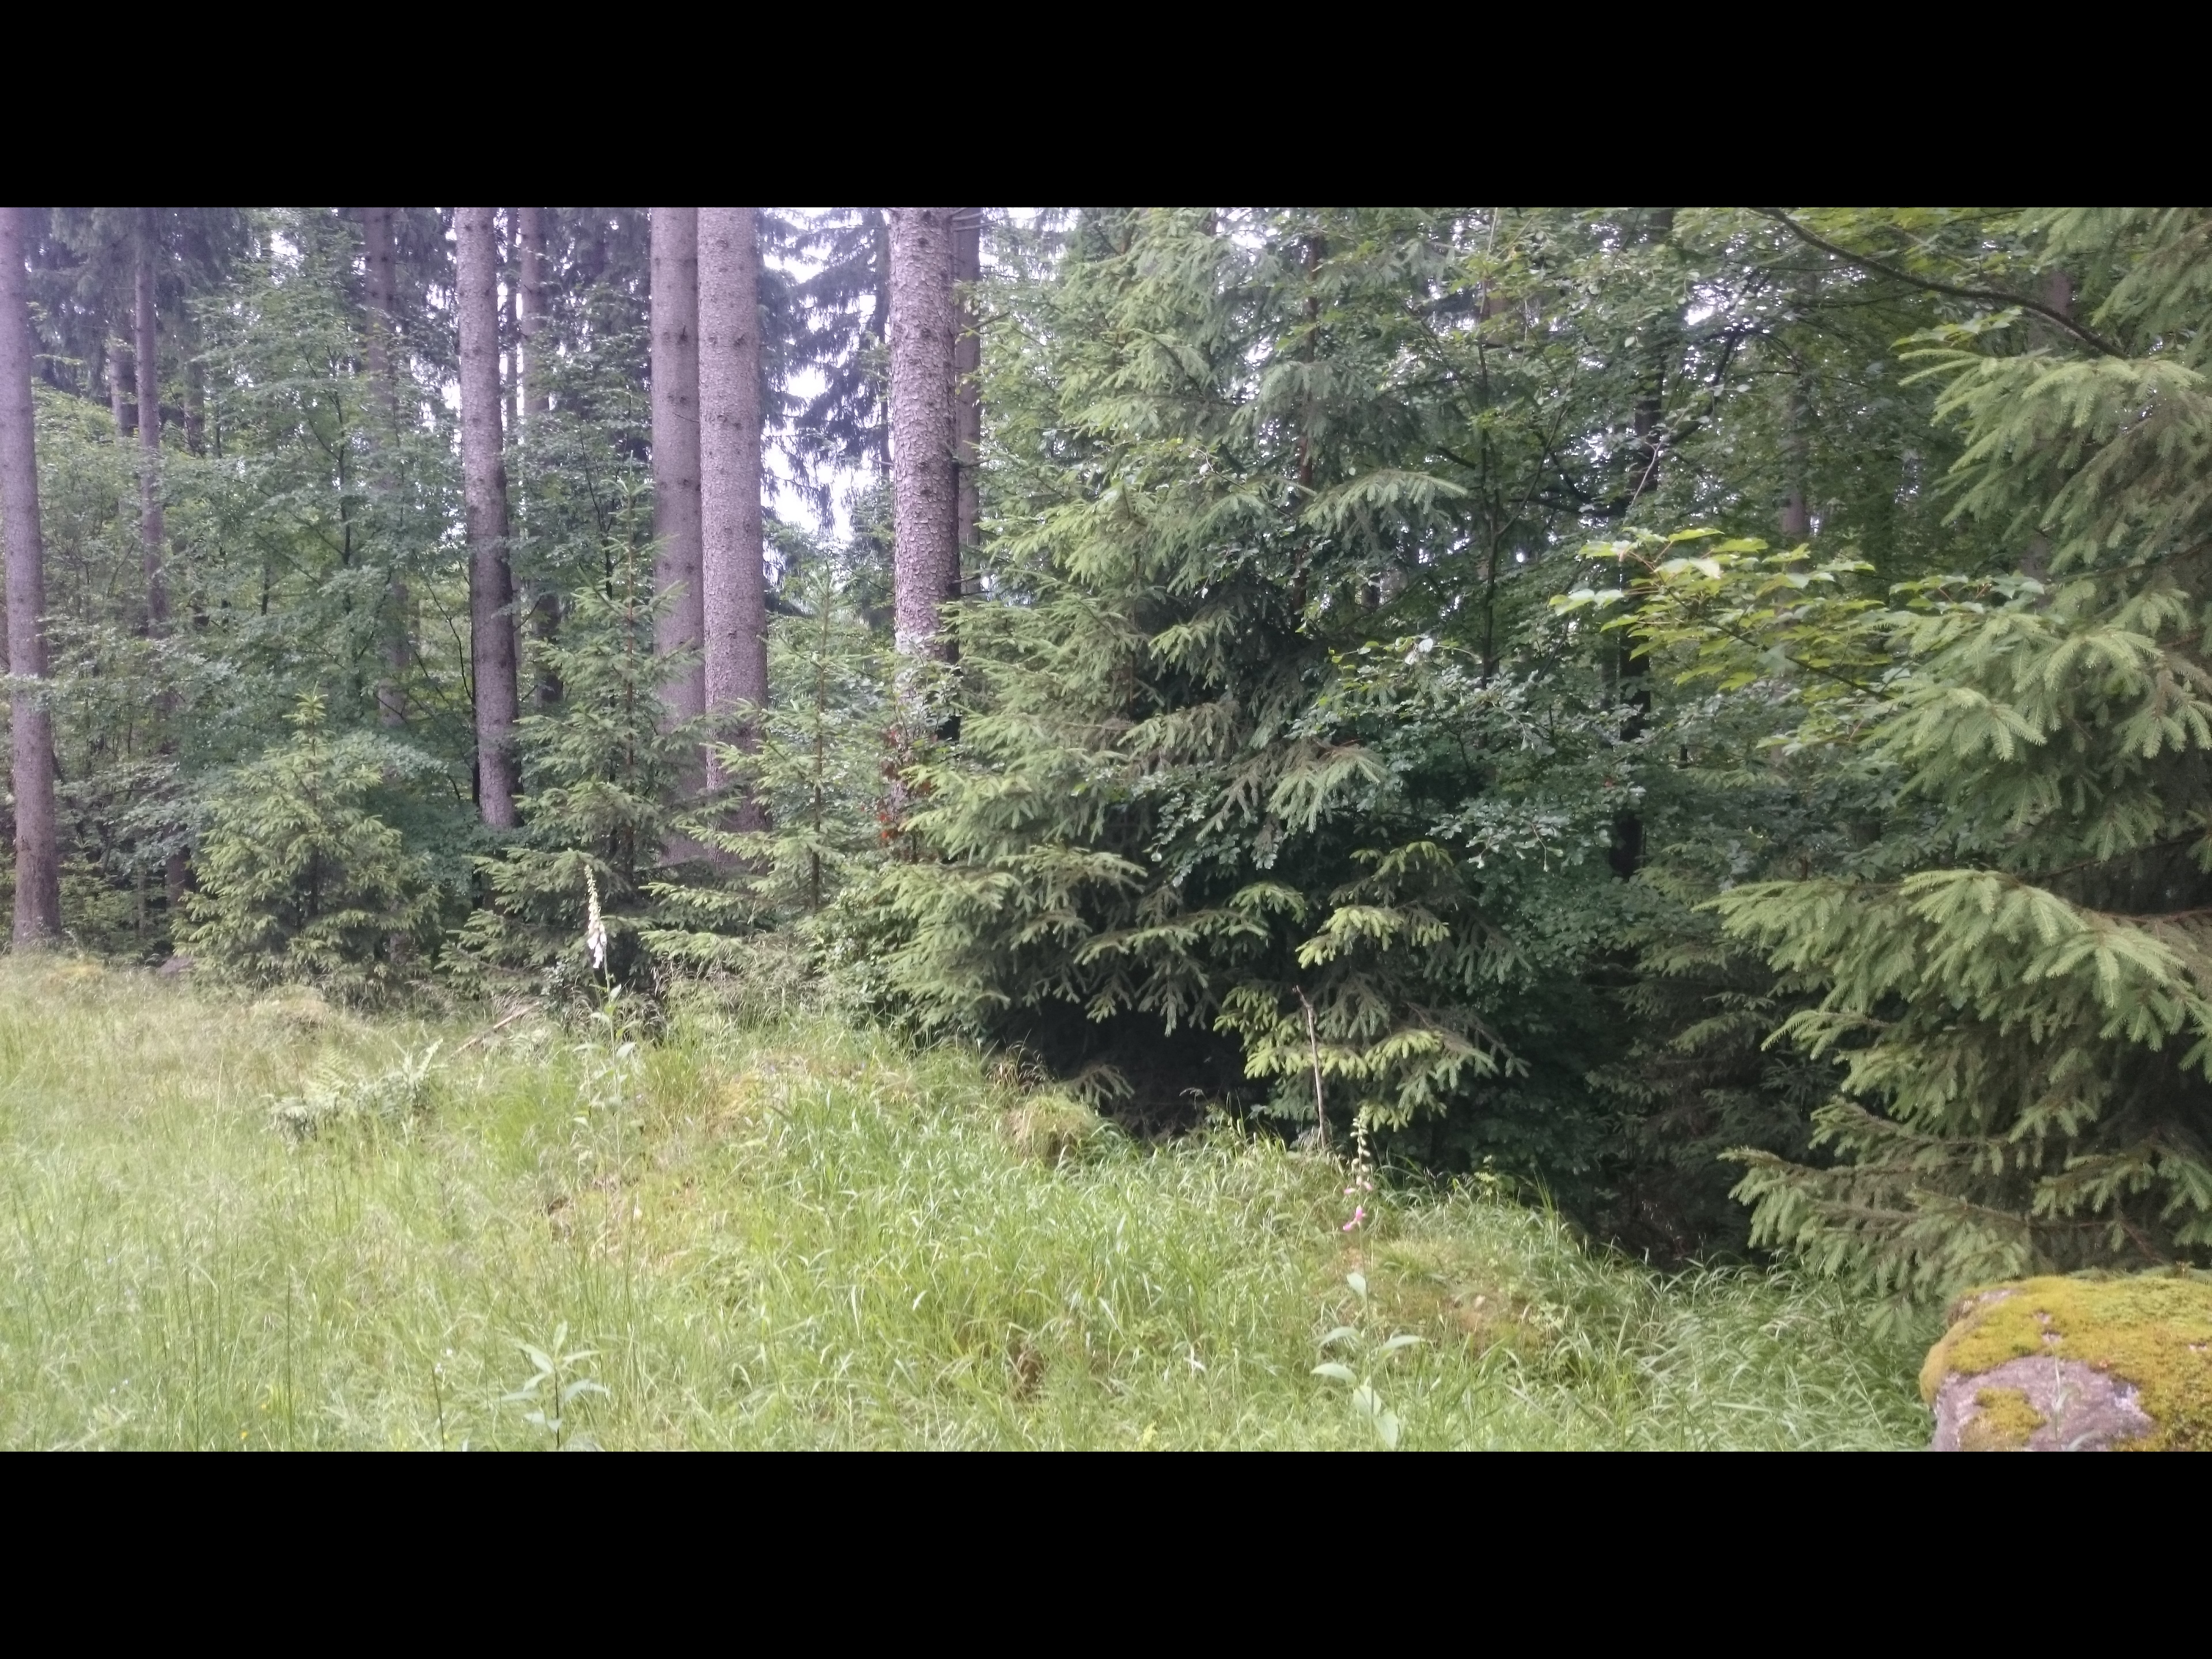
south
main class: Woodland
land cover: Spruce dominated coniferous woodland
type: hemiboreal forest and nemoral coniferous forest and mixed broadleaved-coniferous forest
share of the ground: > 75 %
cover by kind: coniferous forest trees 80 %, shrubs 10 %, unconsolidated bare surface 10 %
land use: Forestry
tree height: > 5 m
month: June
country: AT
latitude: 48.5940
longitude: 14.6517
